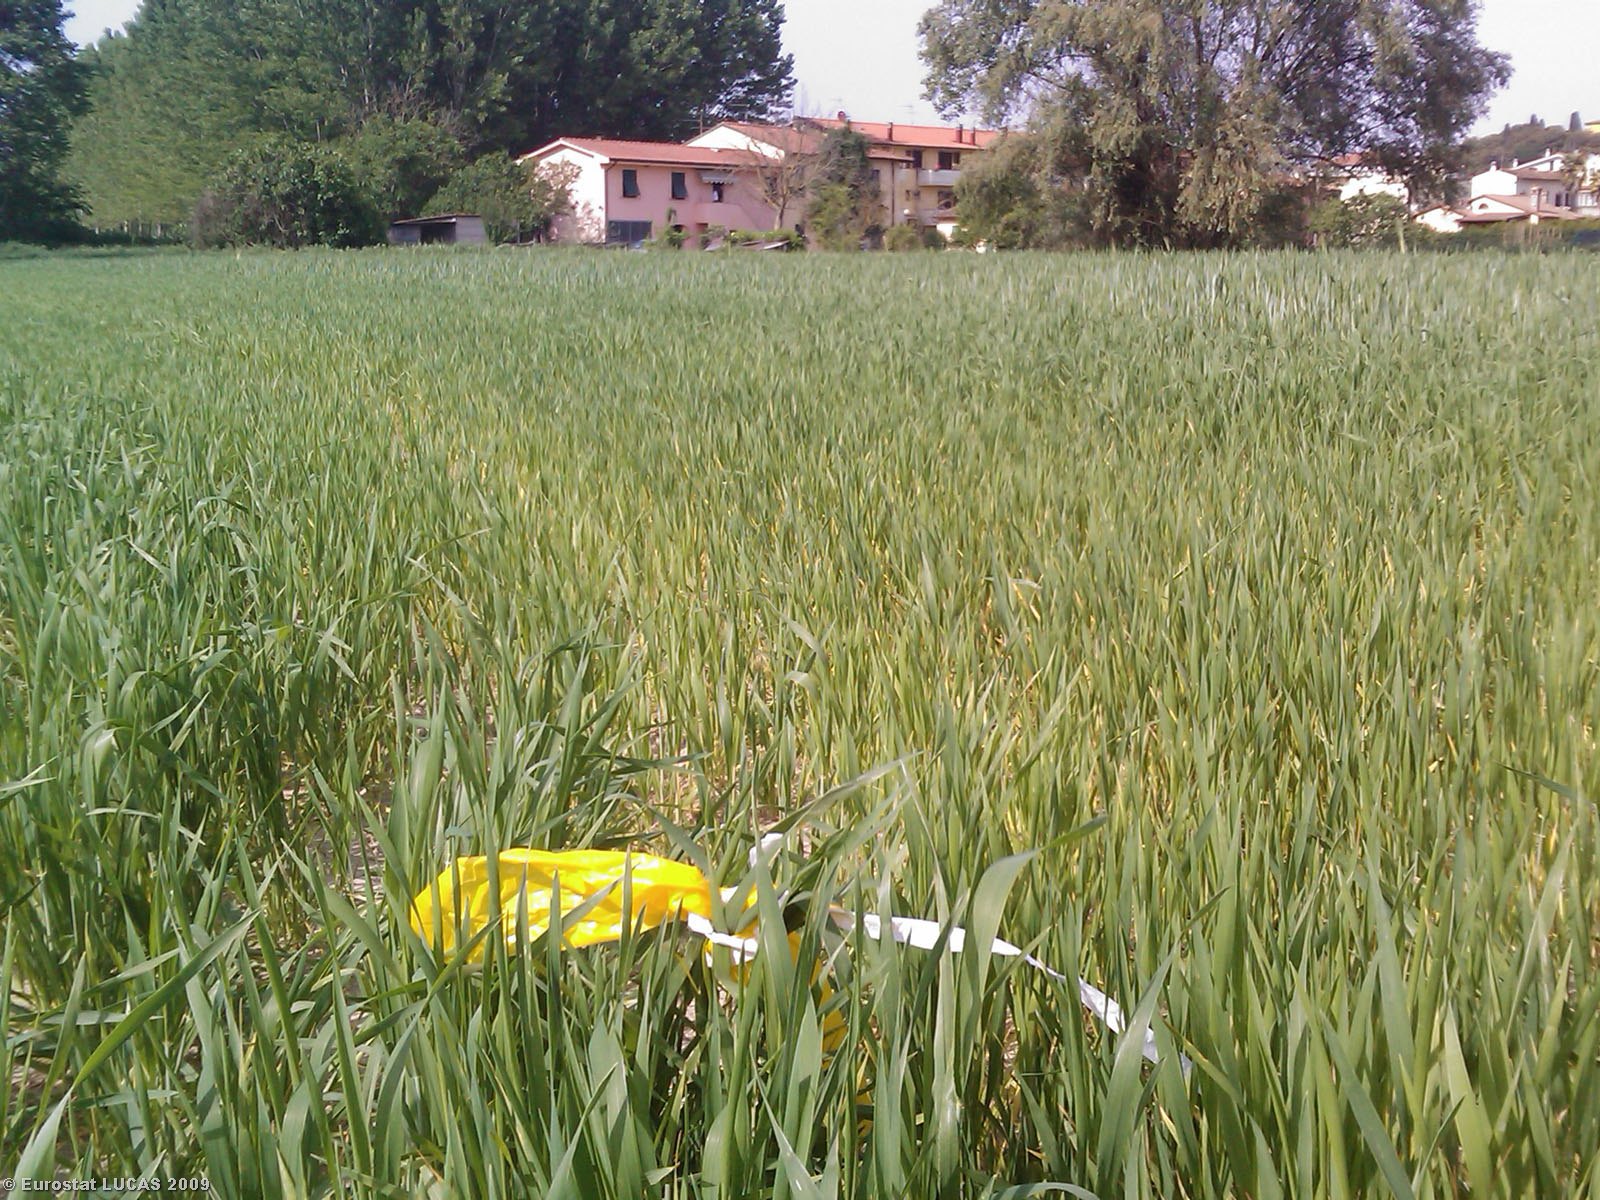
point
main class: Cropland
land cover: Common wheat
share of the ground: > 75 %
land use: Agriculture (excluding fallow land and kitchen gardens)
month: May
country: IT
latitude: 43.6799
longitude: 10.8041
